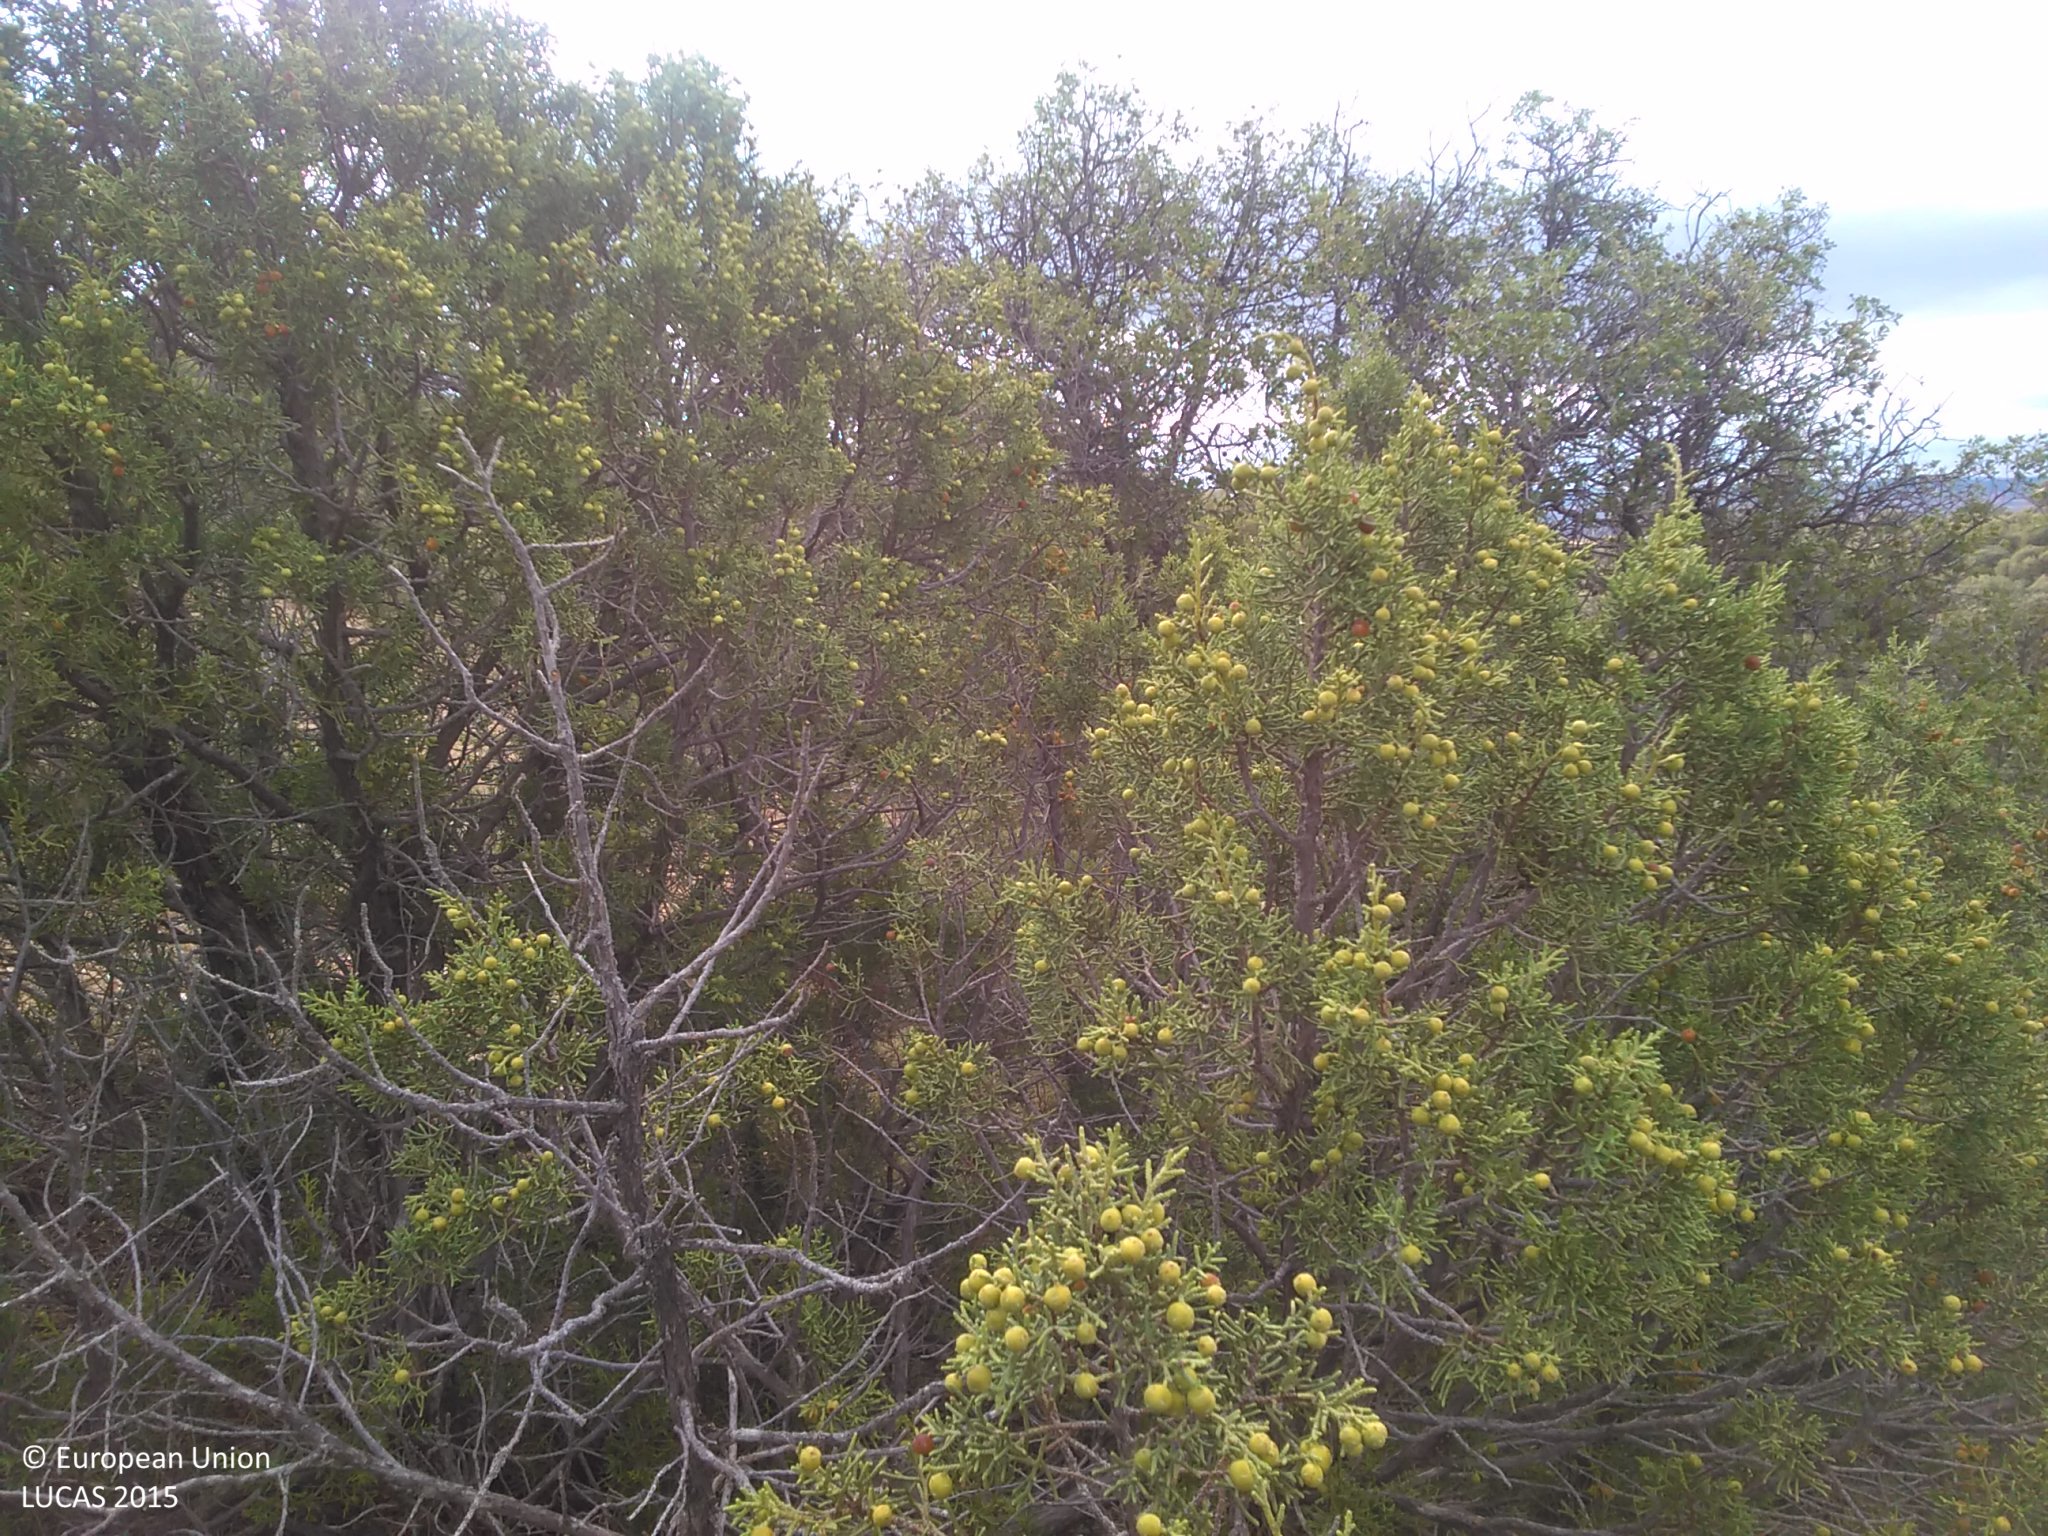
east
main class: Woodland
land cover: Other mixed woodland
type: coniferous forest of the mediterranean region
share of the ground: 25 - 50 %
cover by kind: shrubs 30 %, unconsolidated bare surface 25 %, coniferous forest trees 20 %, broadleaved forest trees 20 %, herbaceous plants 5 %
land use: Semi-natural and natural areas not in use
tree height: < 5 m
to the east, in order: Other mixed woodland; Shrubland with sparse tree cover; Other mixed woodland; Shrubland without tree cover; Shrubland with sparse tree cover; Other mixed woodland; Shrubland without tree cover
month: July
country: ES
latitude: 41.3548
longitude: -1.9934
